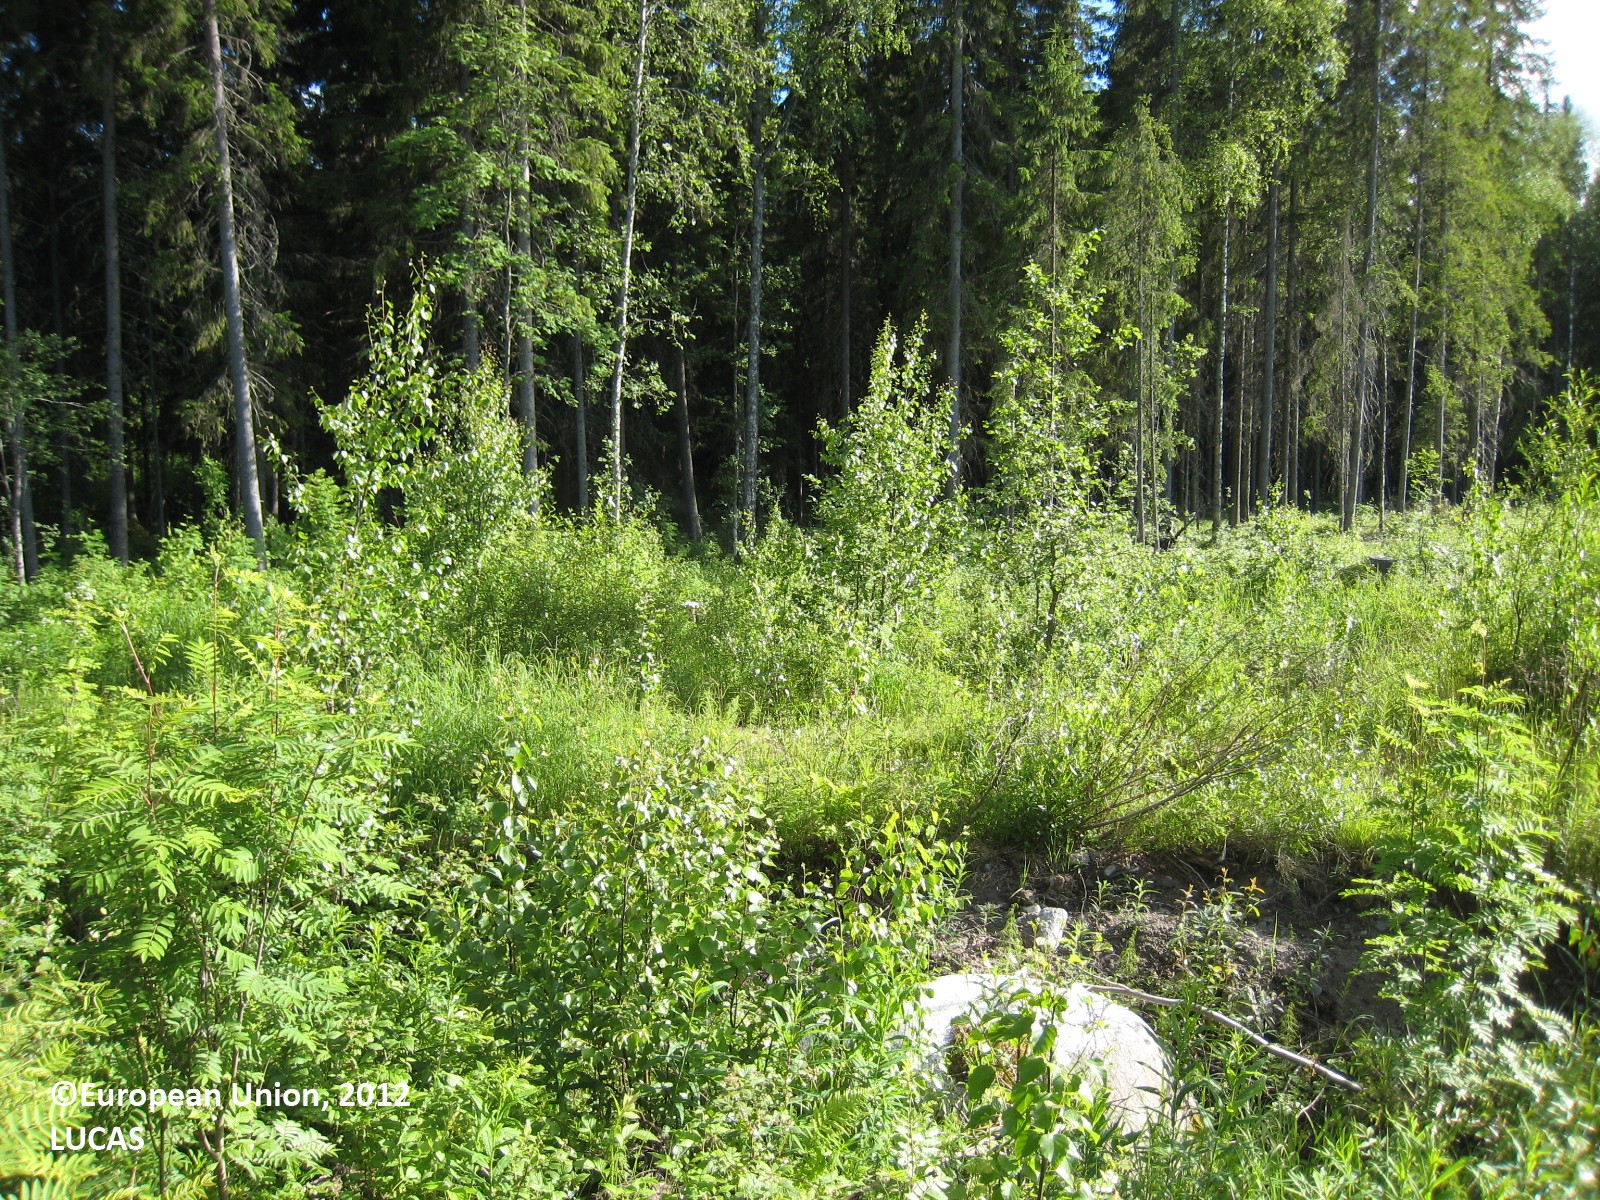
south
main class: Woodland
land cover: Broadleaved woodland
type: boreal forest
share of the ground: 25 - 50 %
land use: Forestry
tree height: < 5 m
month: June
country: FI
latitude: 62.4840
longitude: 26.5335
